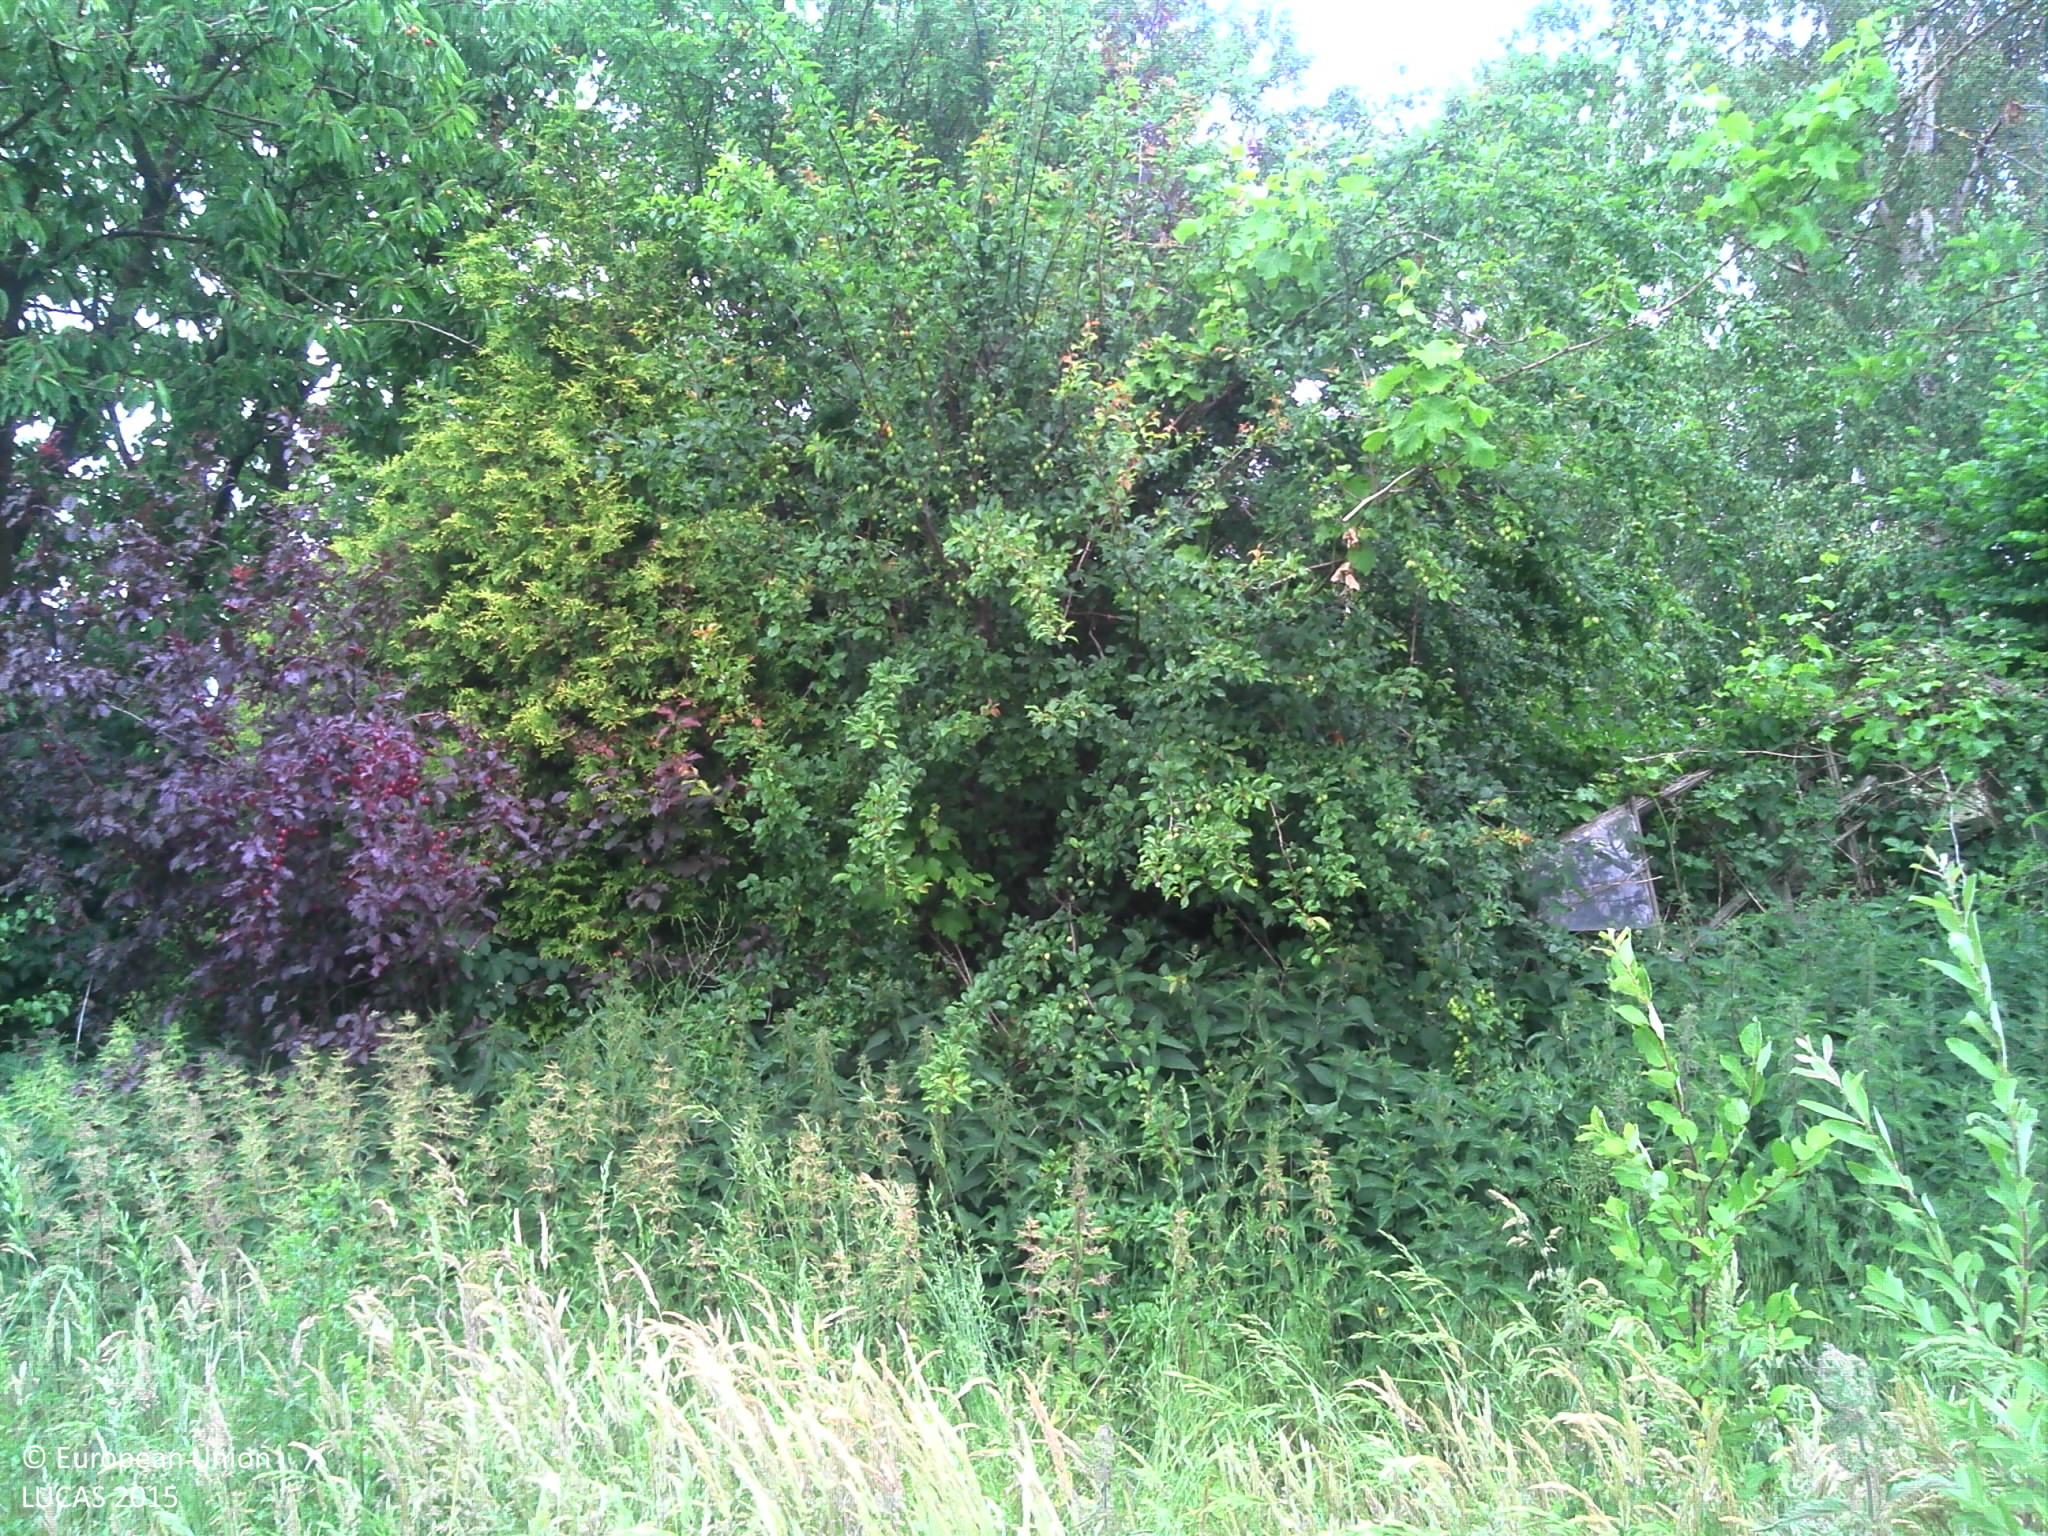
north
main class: Grassland
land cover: Grassland without tree/shrub cover
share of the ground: > 75 %
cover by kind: herbaceous plants 95 %, shrubs 5 %
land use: Agriculture (excluding fallow land and kitchen gardens)
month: June
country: BE
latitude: 50.8817
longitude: 4.5236
